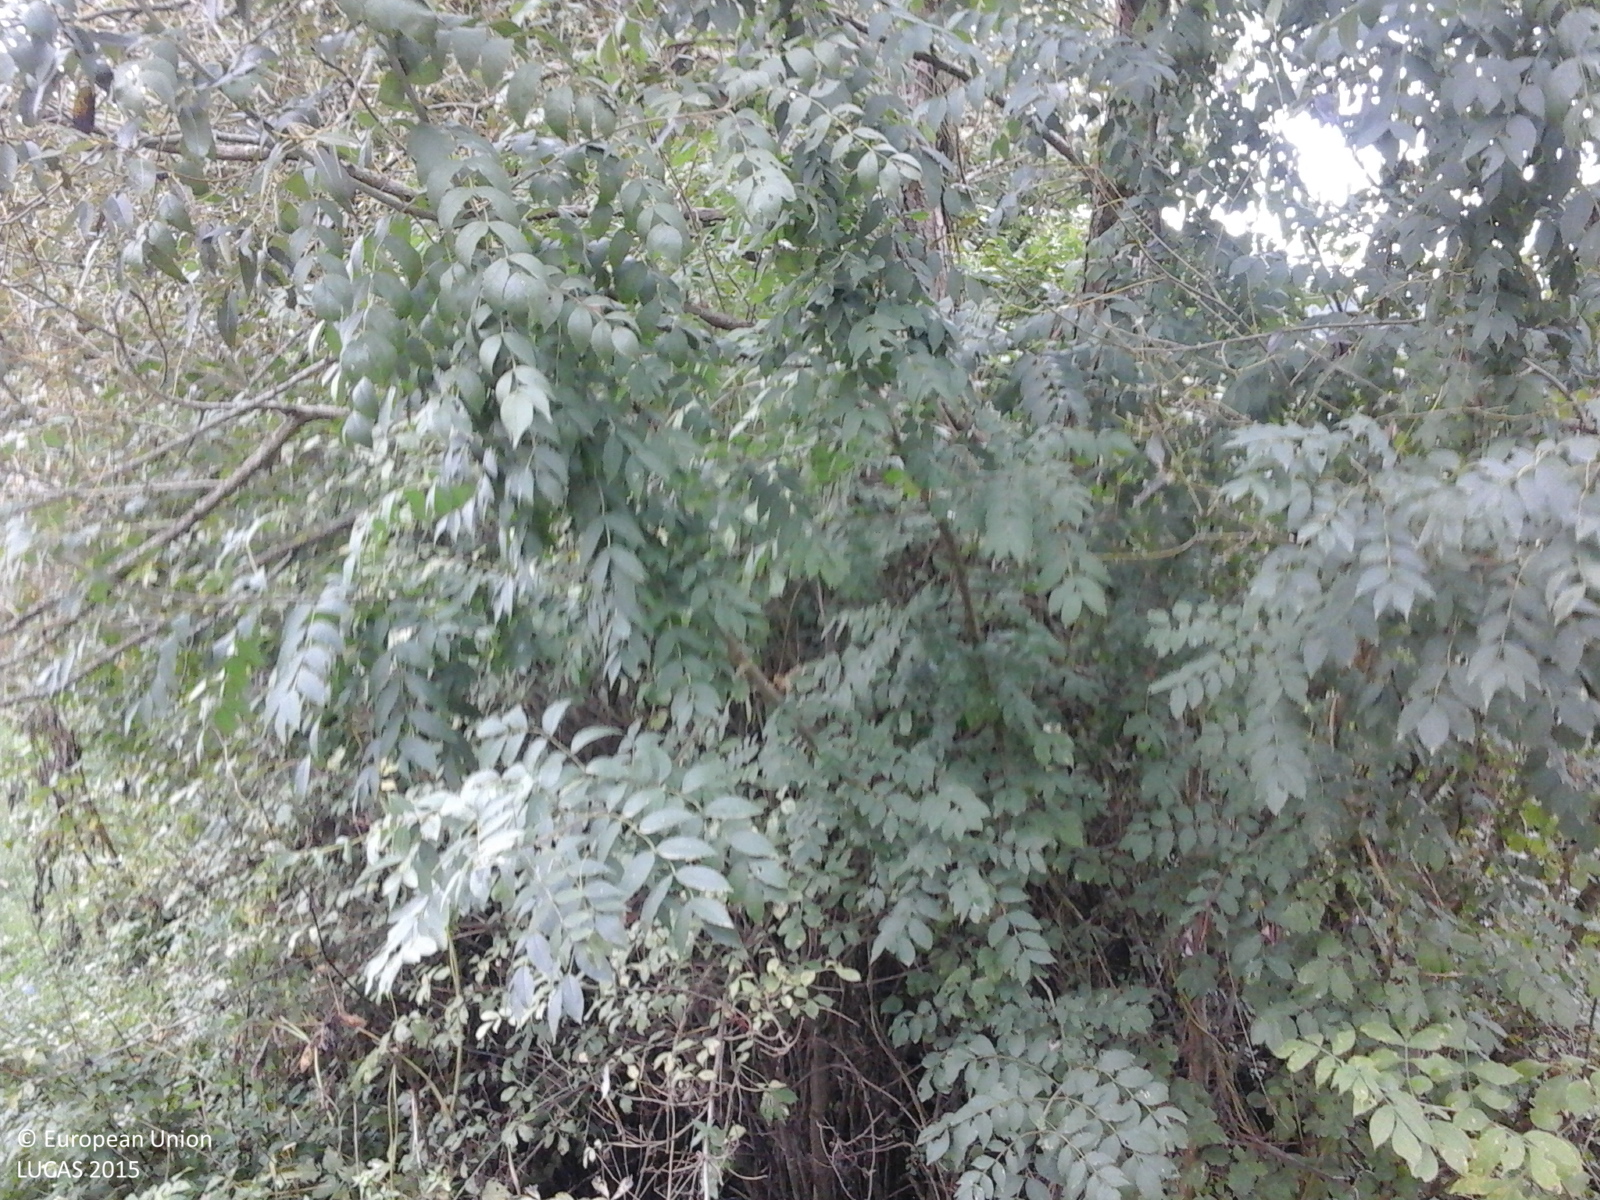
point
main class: Shrubland
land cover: Shrubland with sparse tree cover
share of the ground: > 75 %
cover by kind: shrubs 95 %, broadleaved forest trees 5 %
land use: Semi-natural and natural areas not in use
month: September
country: RO
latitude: 45.9138
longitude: 22.2797
